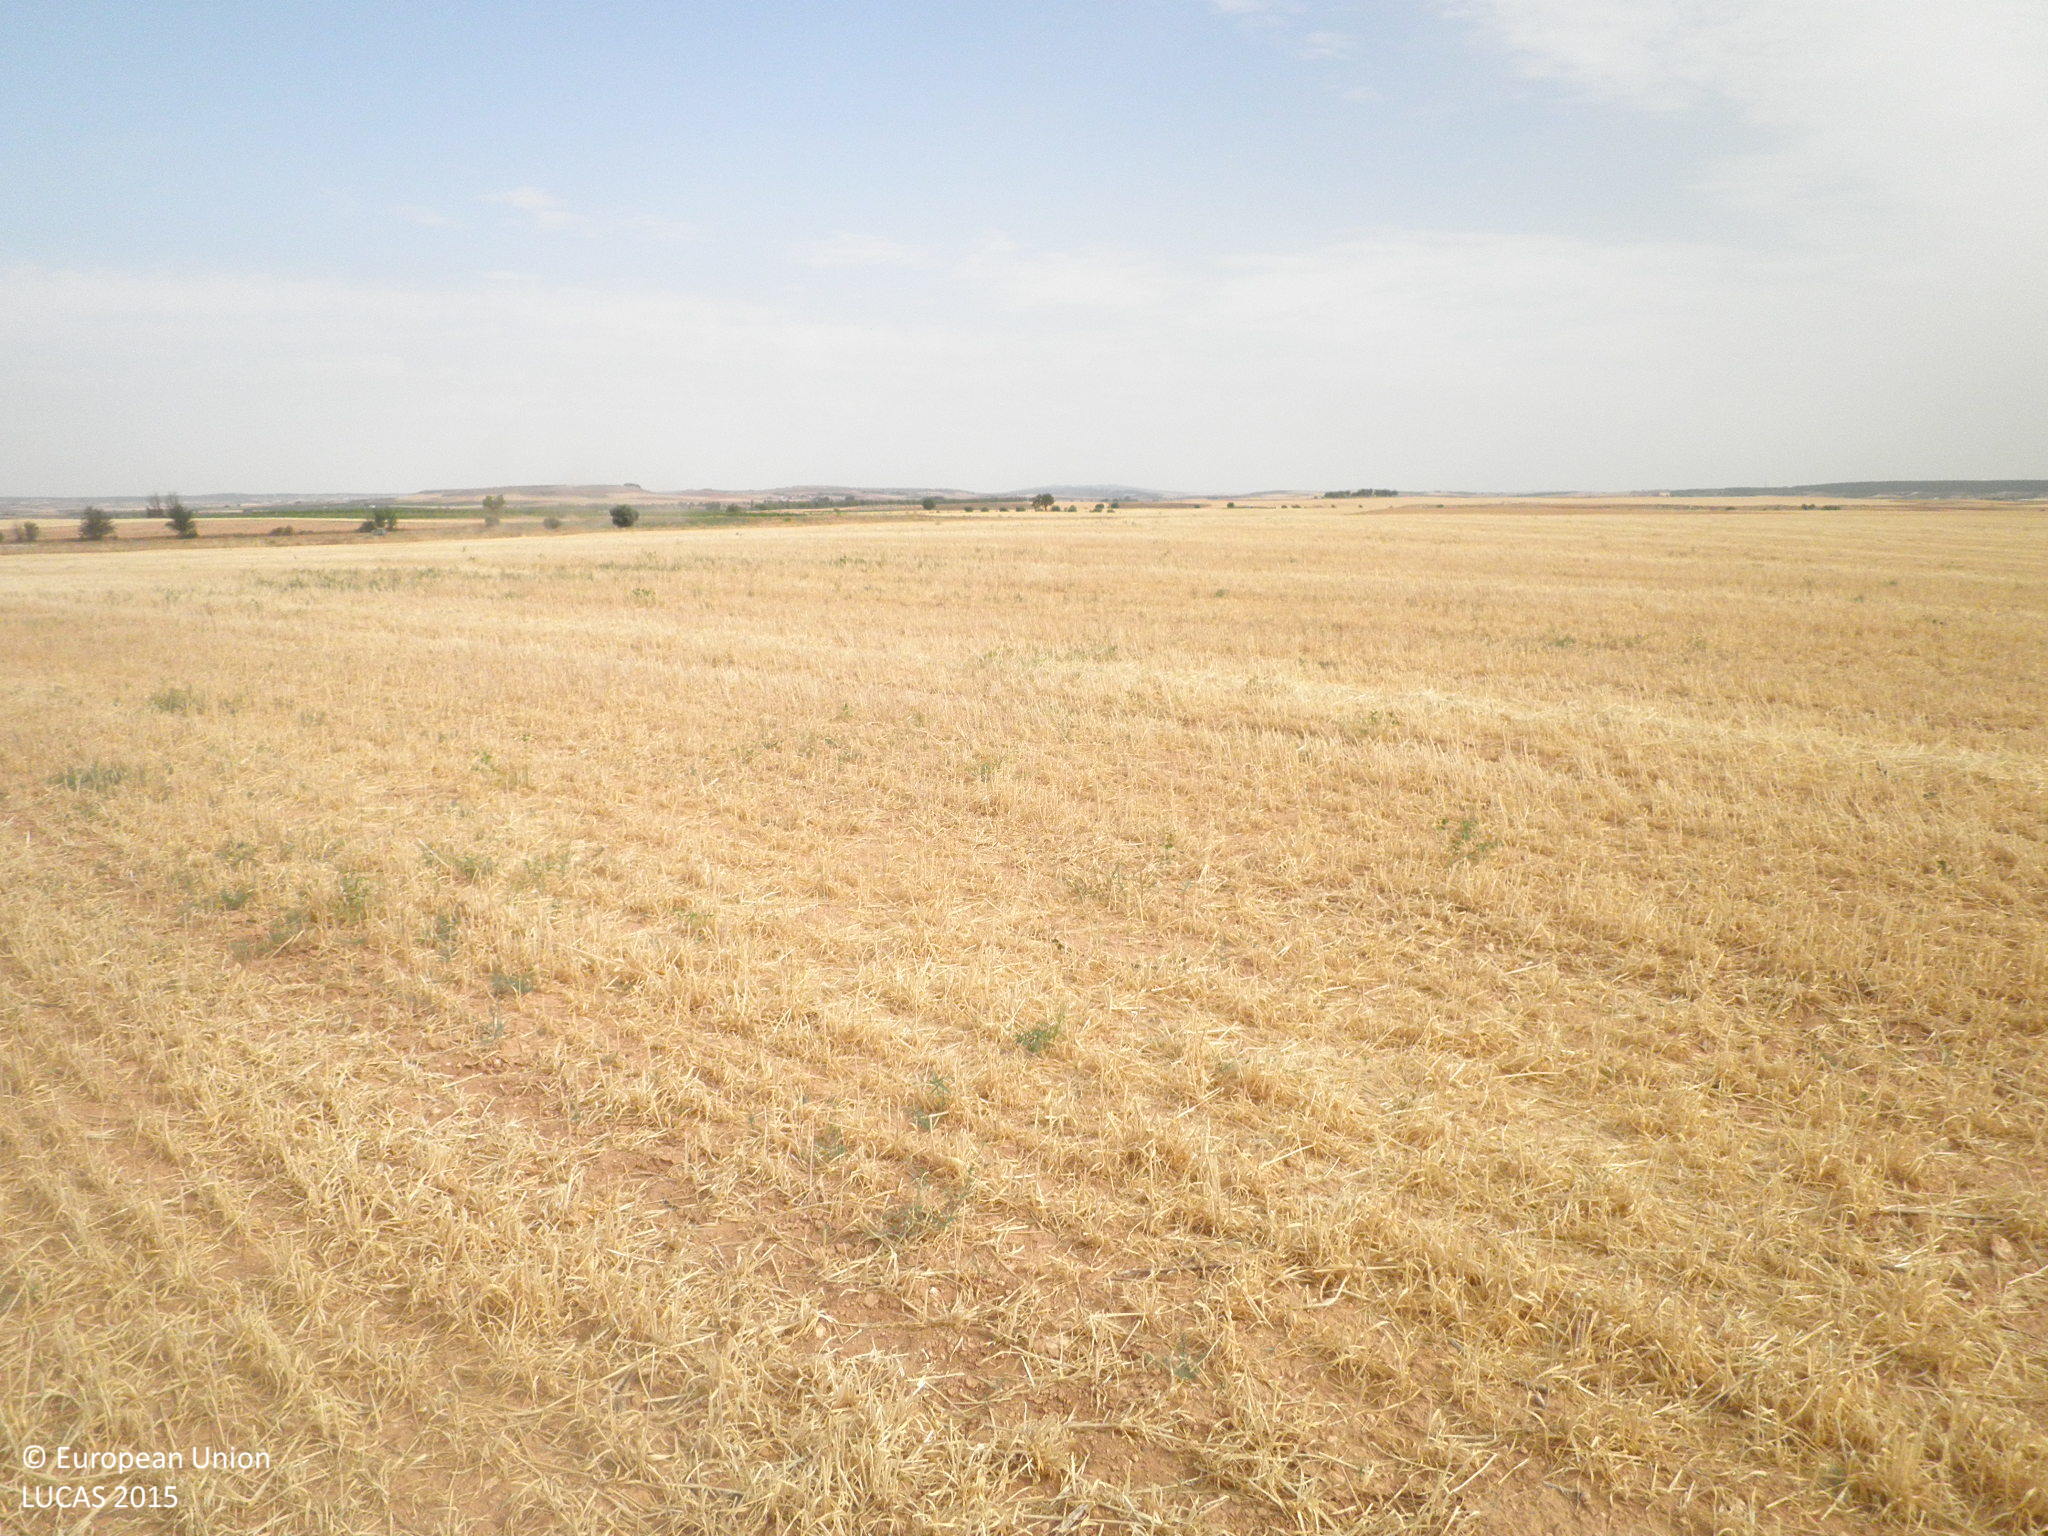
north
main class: Cropland
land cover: Barley
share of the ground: 50 - 75 %
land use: Agriculture (excluding fallow land and kitchen gardens)
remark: Harvested field
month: July
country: ES
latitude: 39.5259
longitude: -2.7298
